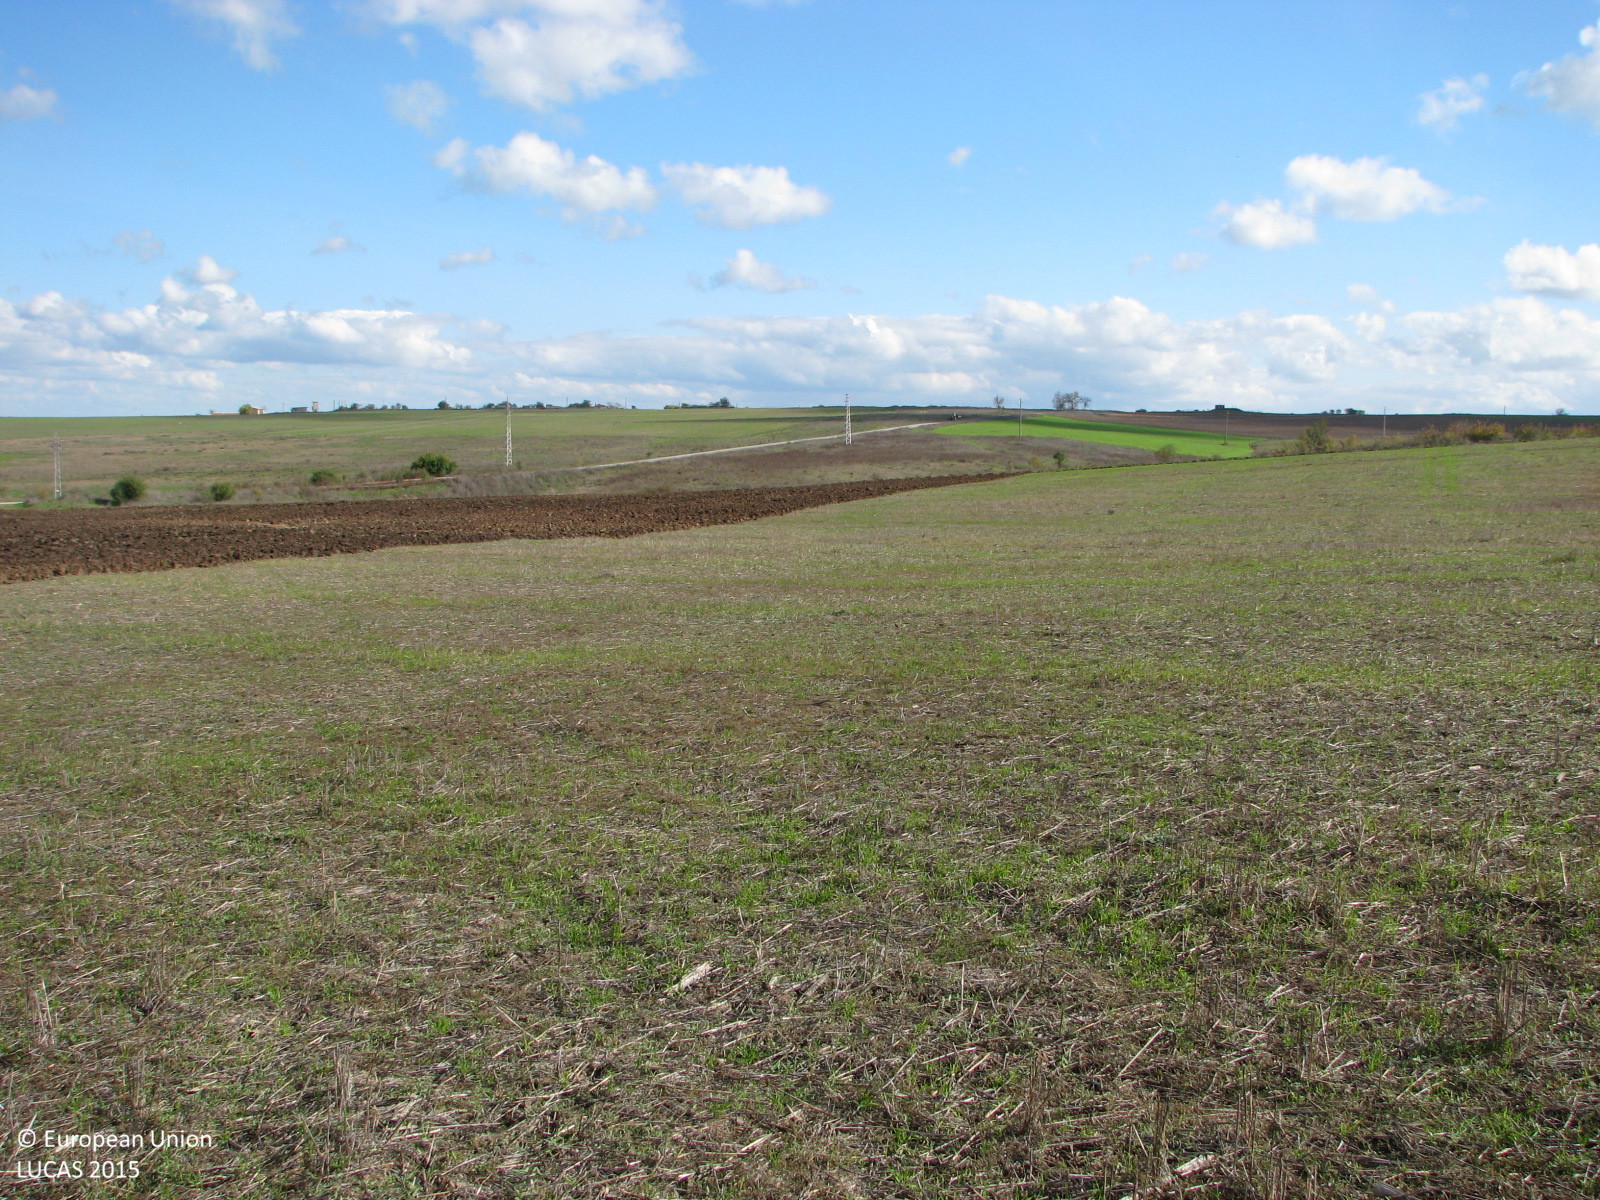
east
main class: Cropland
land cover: Common wheat
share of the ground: 25 - 50 %
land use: Agriculture (excluding fallow land and kitchen gardens)
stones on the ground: < 10 %
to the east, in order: Common wheat; Other bare soil; Grass margins; Tracks; Grassland with sparse tree/shrub cover
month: October
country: BG
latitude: 42.3062
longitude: 26.8016
